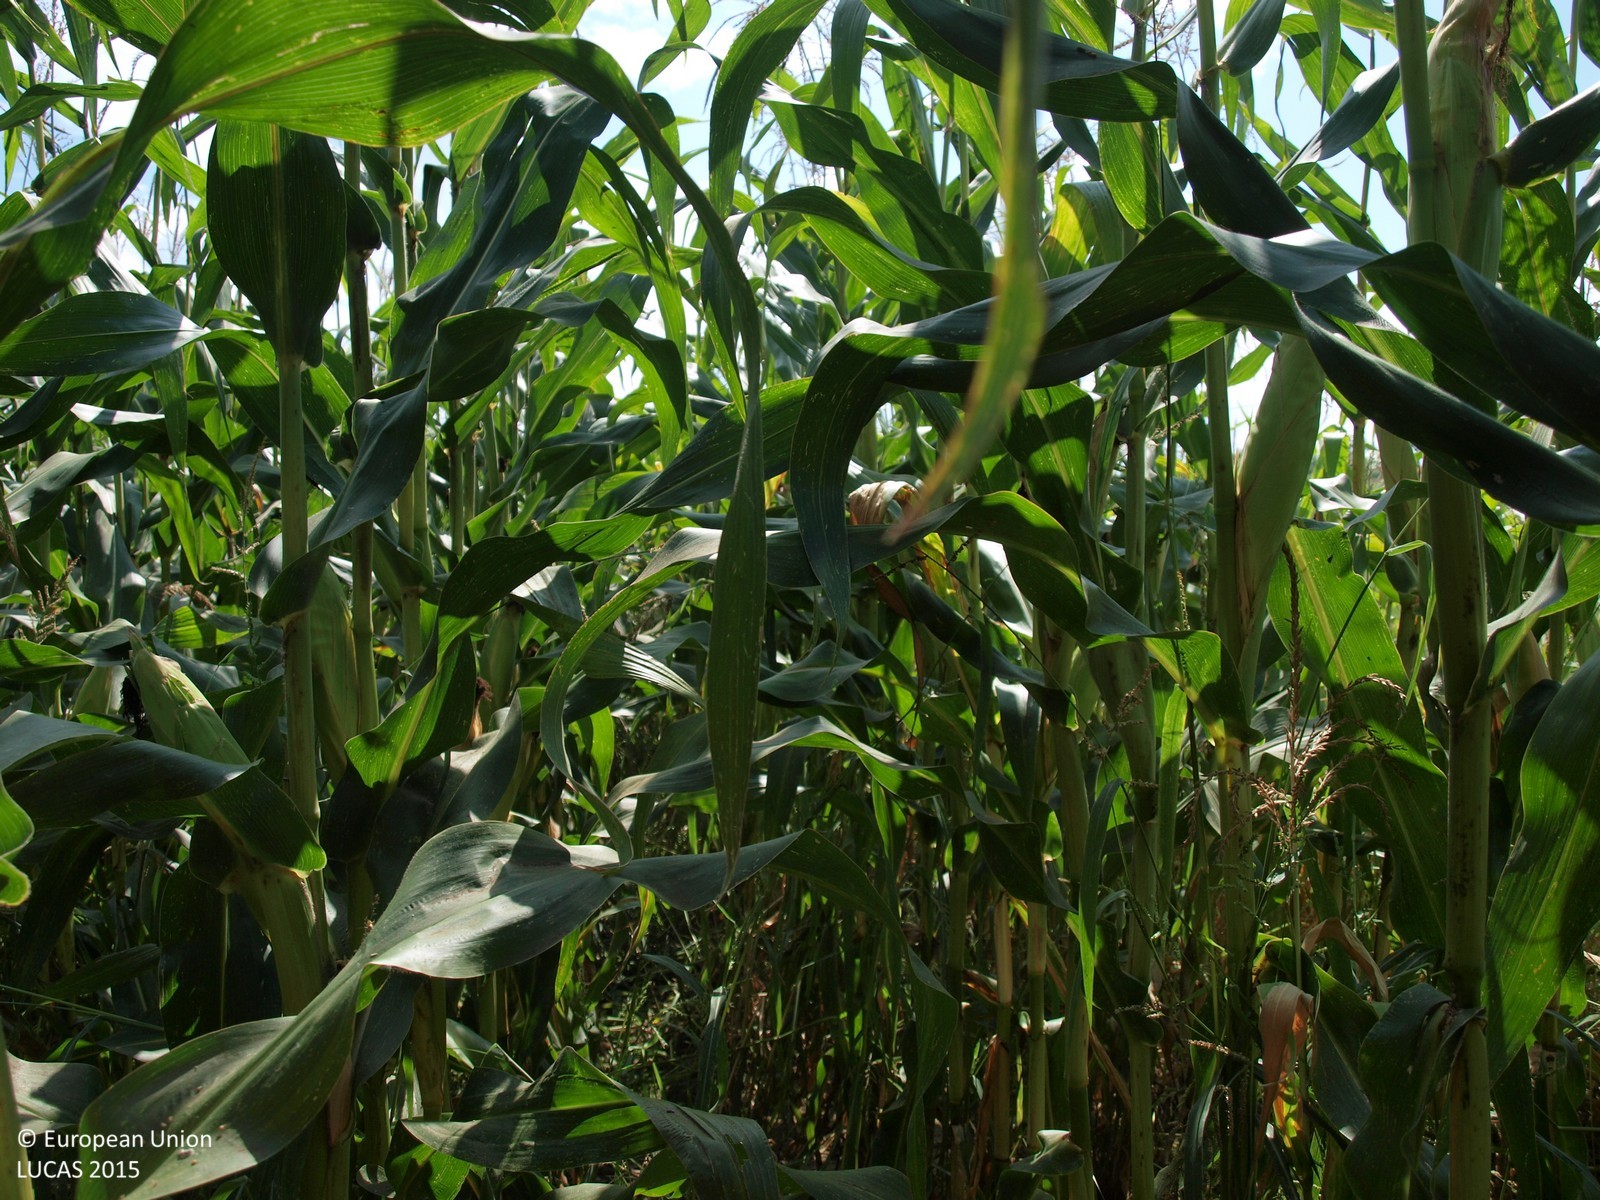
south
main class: Cropland
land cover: Maize
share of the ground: > 75 %
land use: Agriculture (excluding fallow land and kitchen gardens)
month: August
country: HR
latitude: 46.0793
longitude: 16.5301
